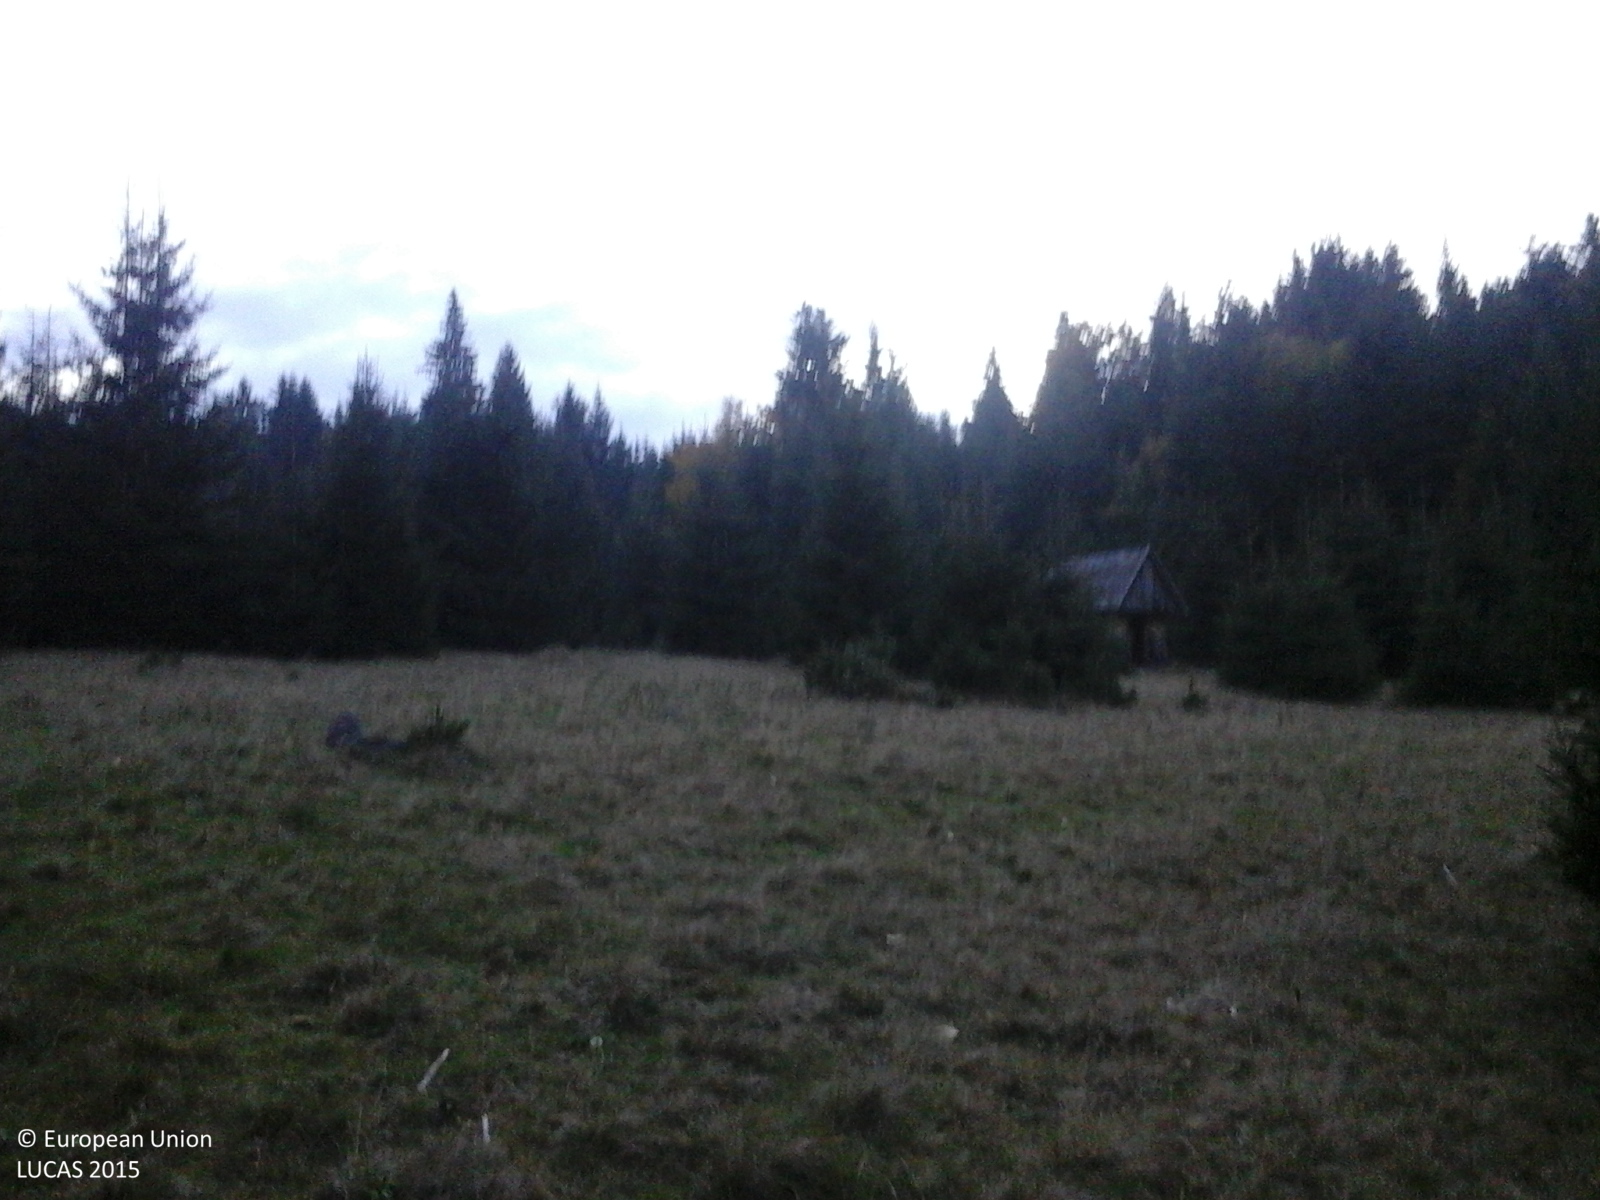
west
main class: Grassland
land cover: Spontaneously vegetated surfaces
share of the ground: > 75 %
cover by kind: herbaceous plants 100 %
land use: Fallow land
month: October
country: RO
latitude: 46.6377
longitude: 25.4047
